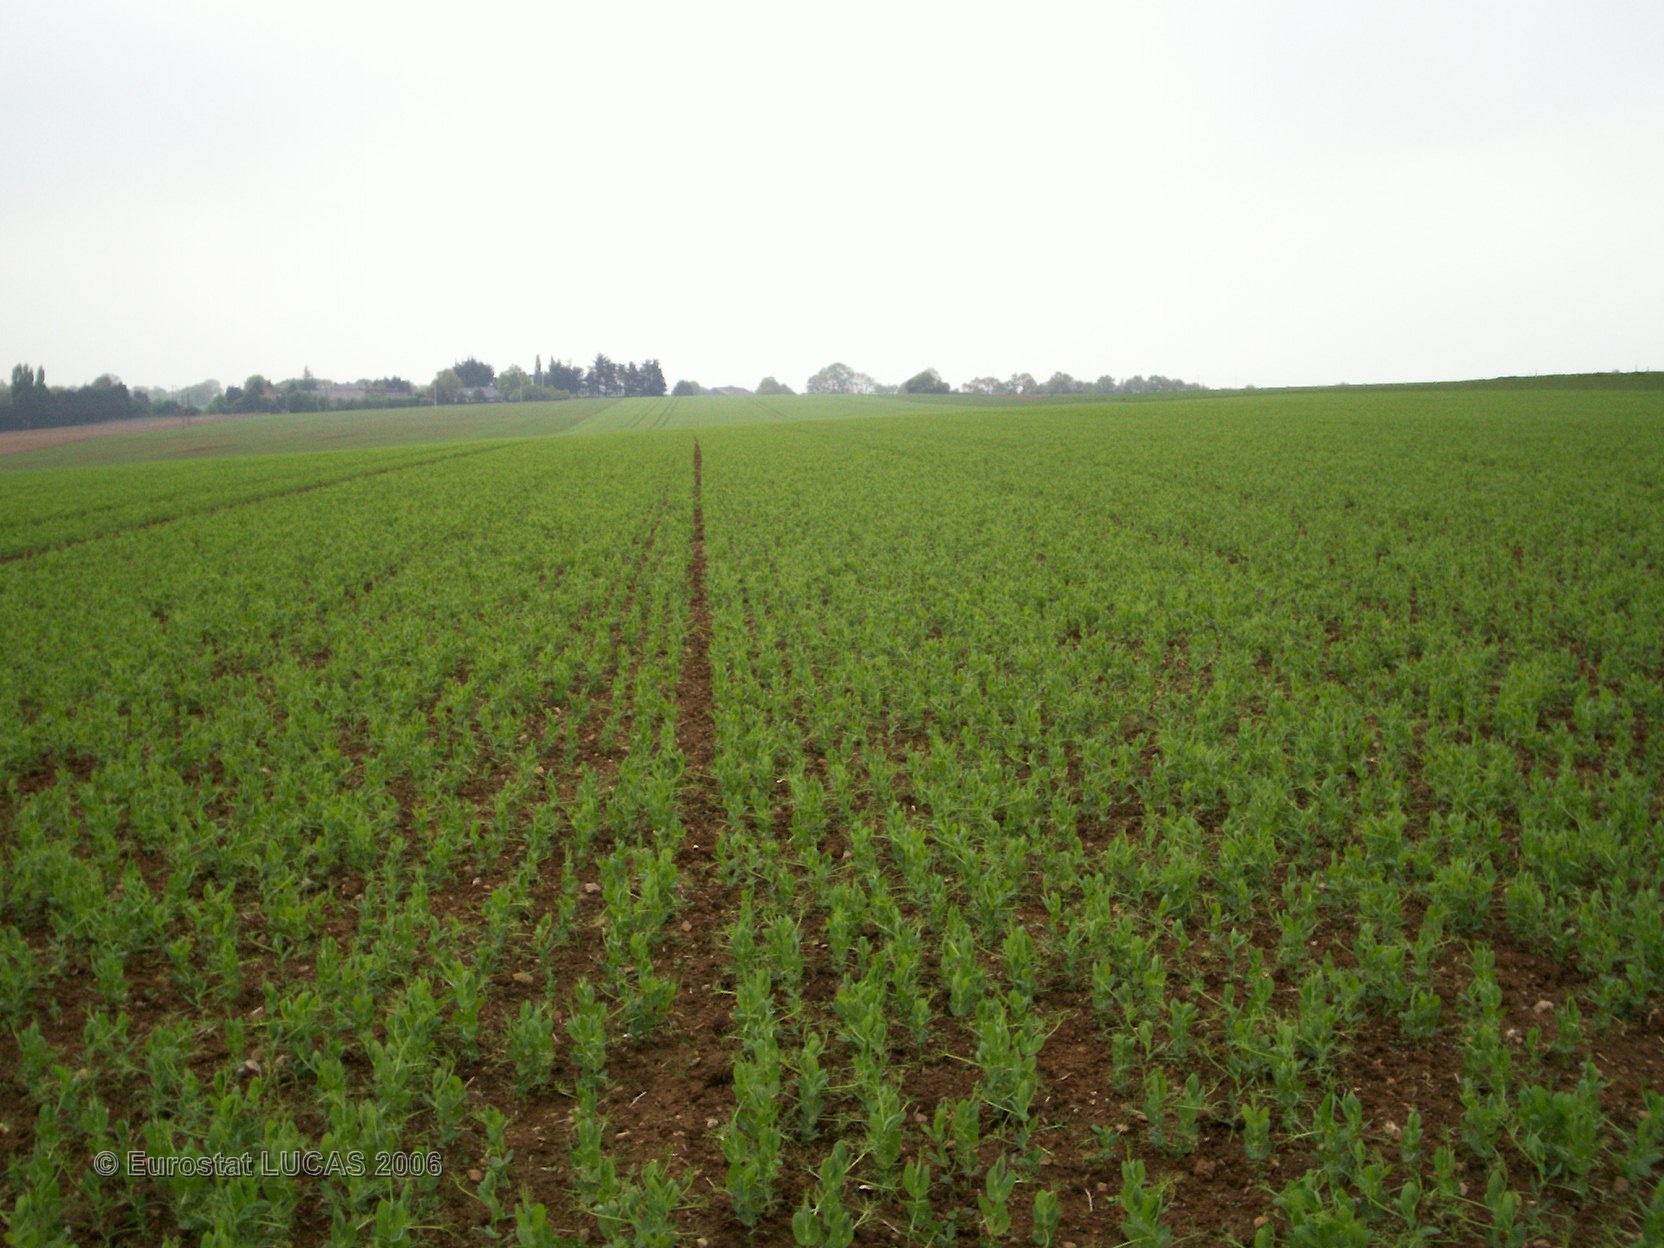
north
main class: Cropland
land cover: Dry pulses
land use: Agriculture (excluding fallow land and kitchen gardens)
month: May
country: FR
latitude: 48.1921
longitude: -2.8870
